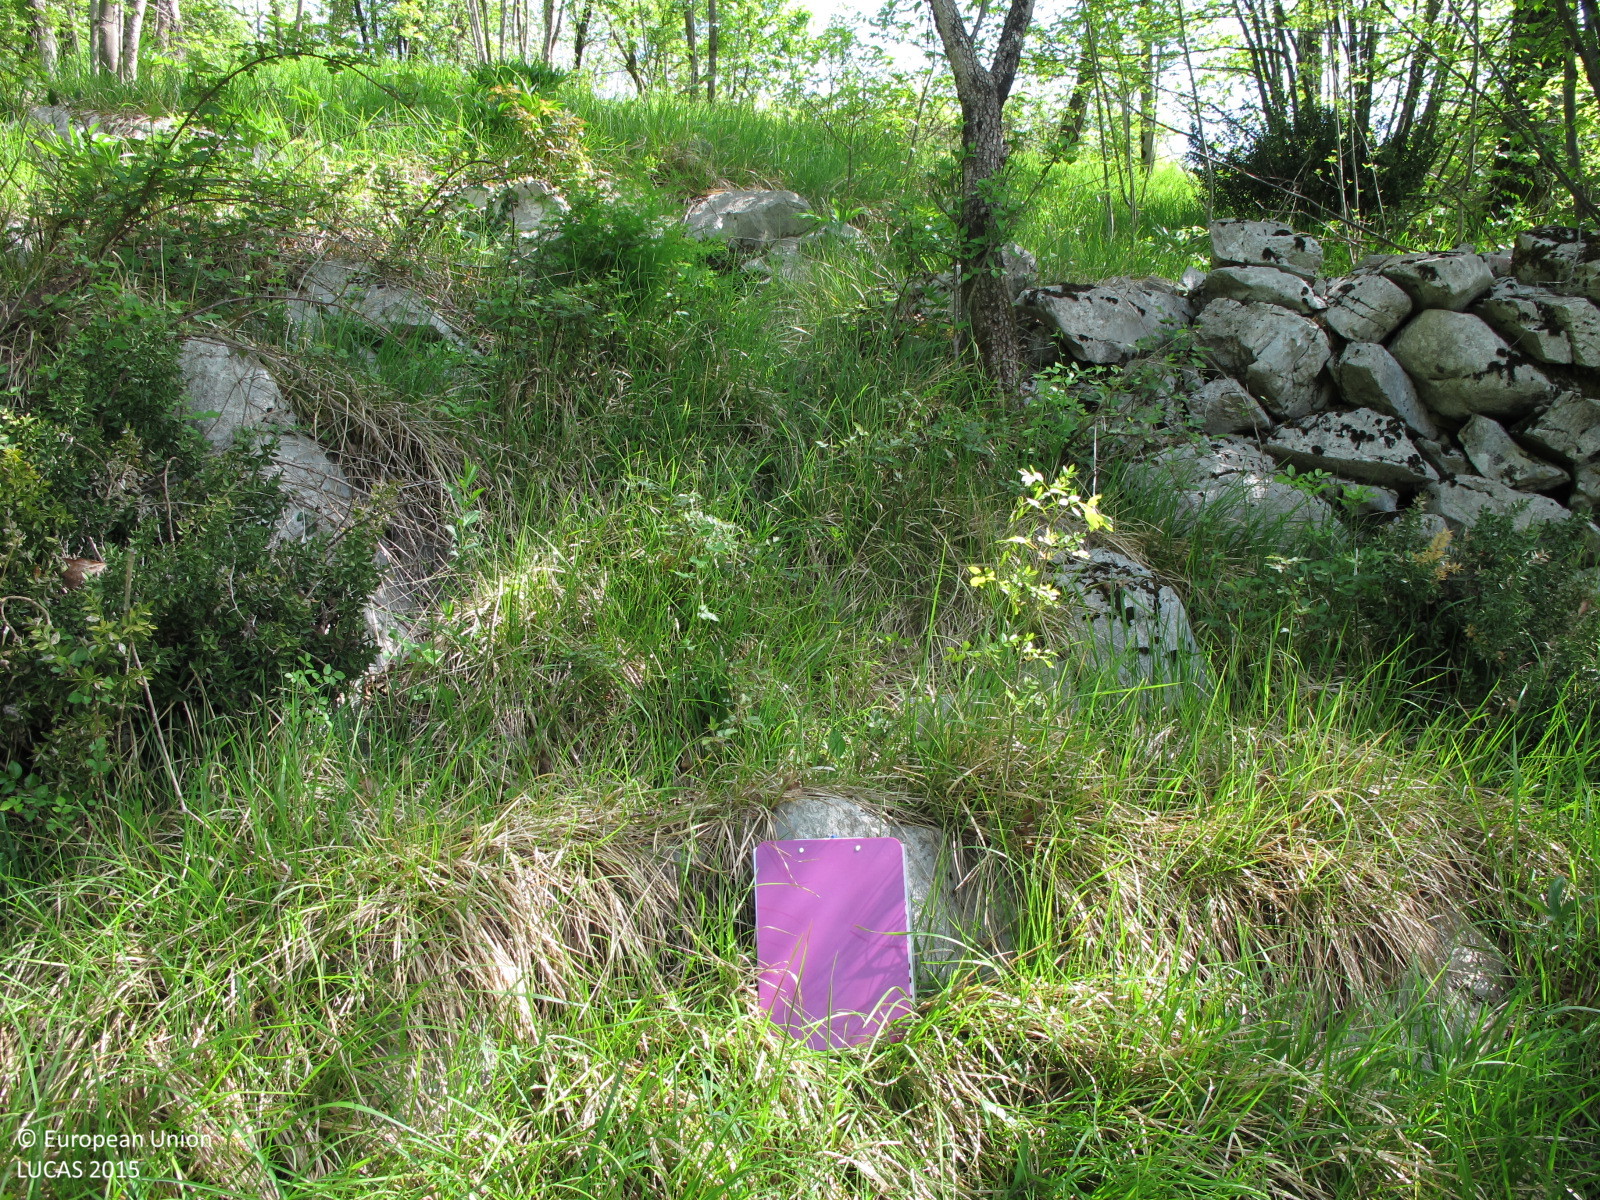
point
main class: Woodland
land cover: Broadleaved woodland
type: thermophilous deciduous forest
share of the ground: > 75 %
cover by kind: broadleaved forest trees 80 %, shrubs 5 %, herbaceous plants 5 %, consolidated bare surface 5 %
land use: Forestry
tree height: > 5 m
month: May
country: HR
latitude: 45.3988
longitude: 14.3002
